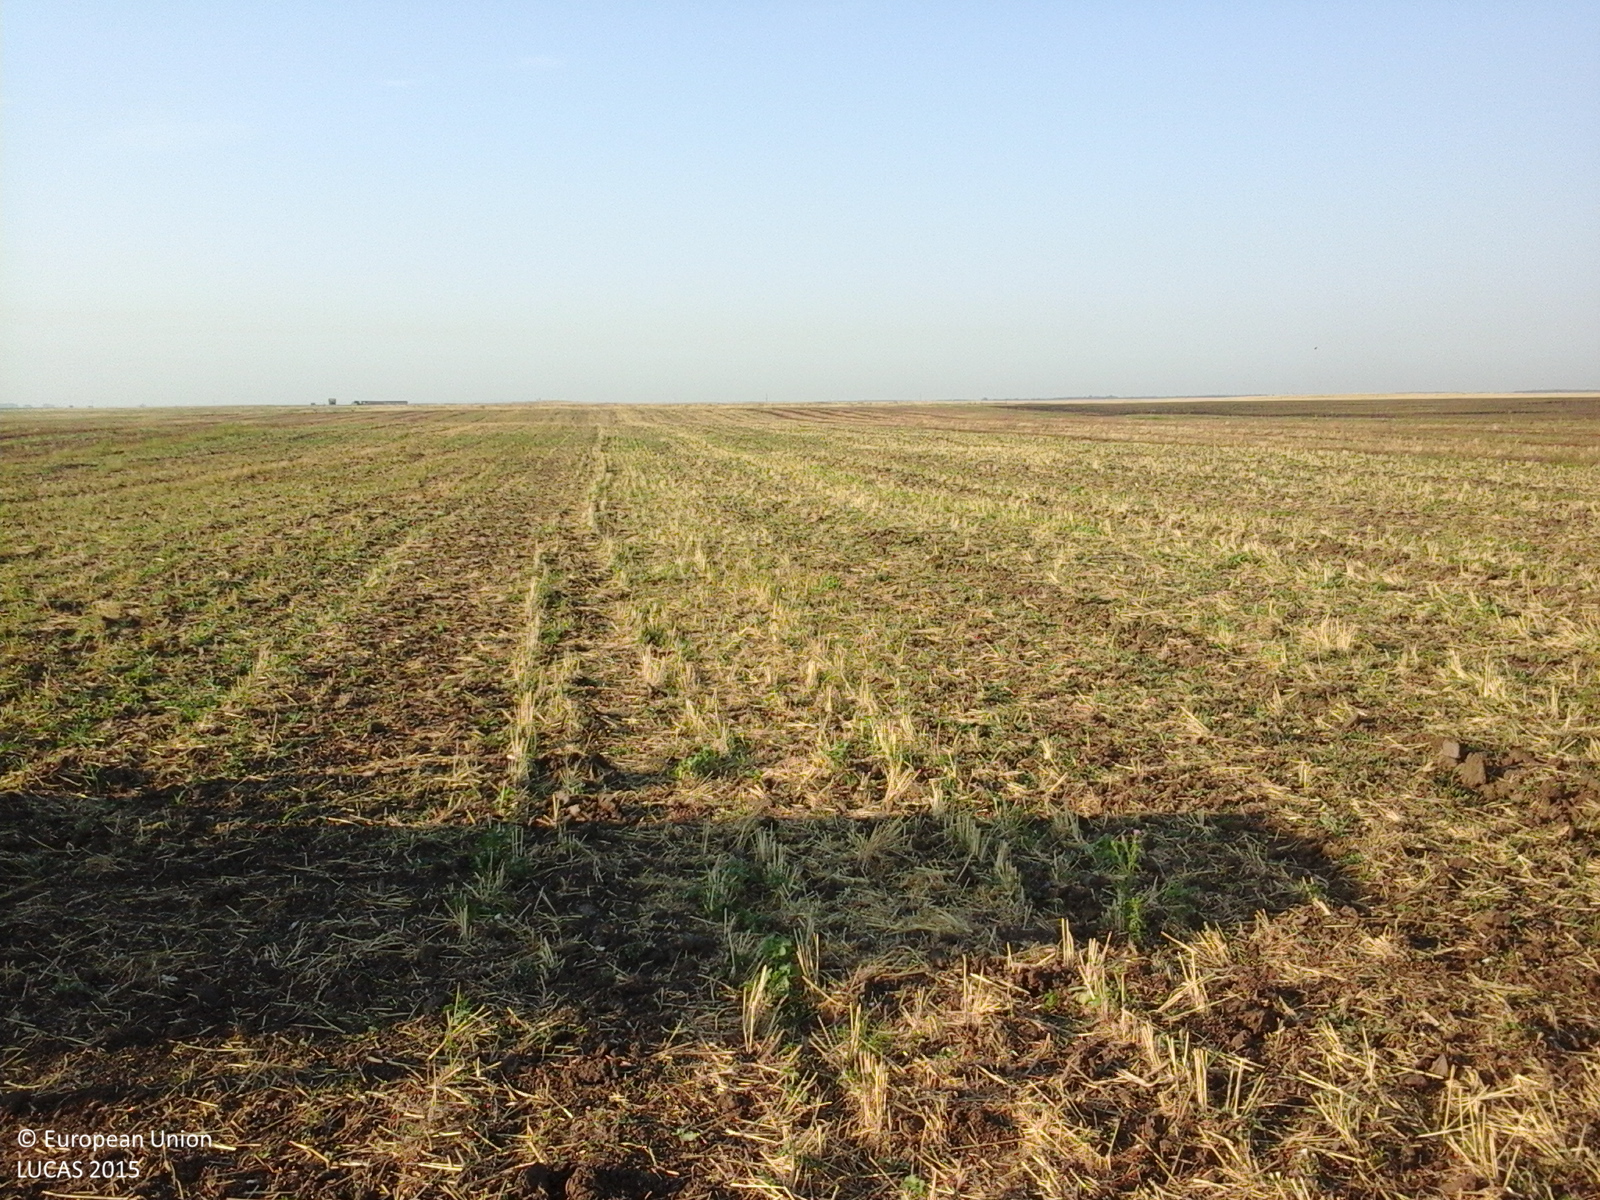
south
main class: Cropland
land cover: Common wheat
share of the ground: 50 - 75 %
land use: Agriculture (excluding fallow land and kitchen gardens)
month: August
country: RO
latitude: 44.0783
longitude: 23.2702
